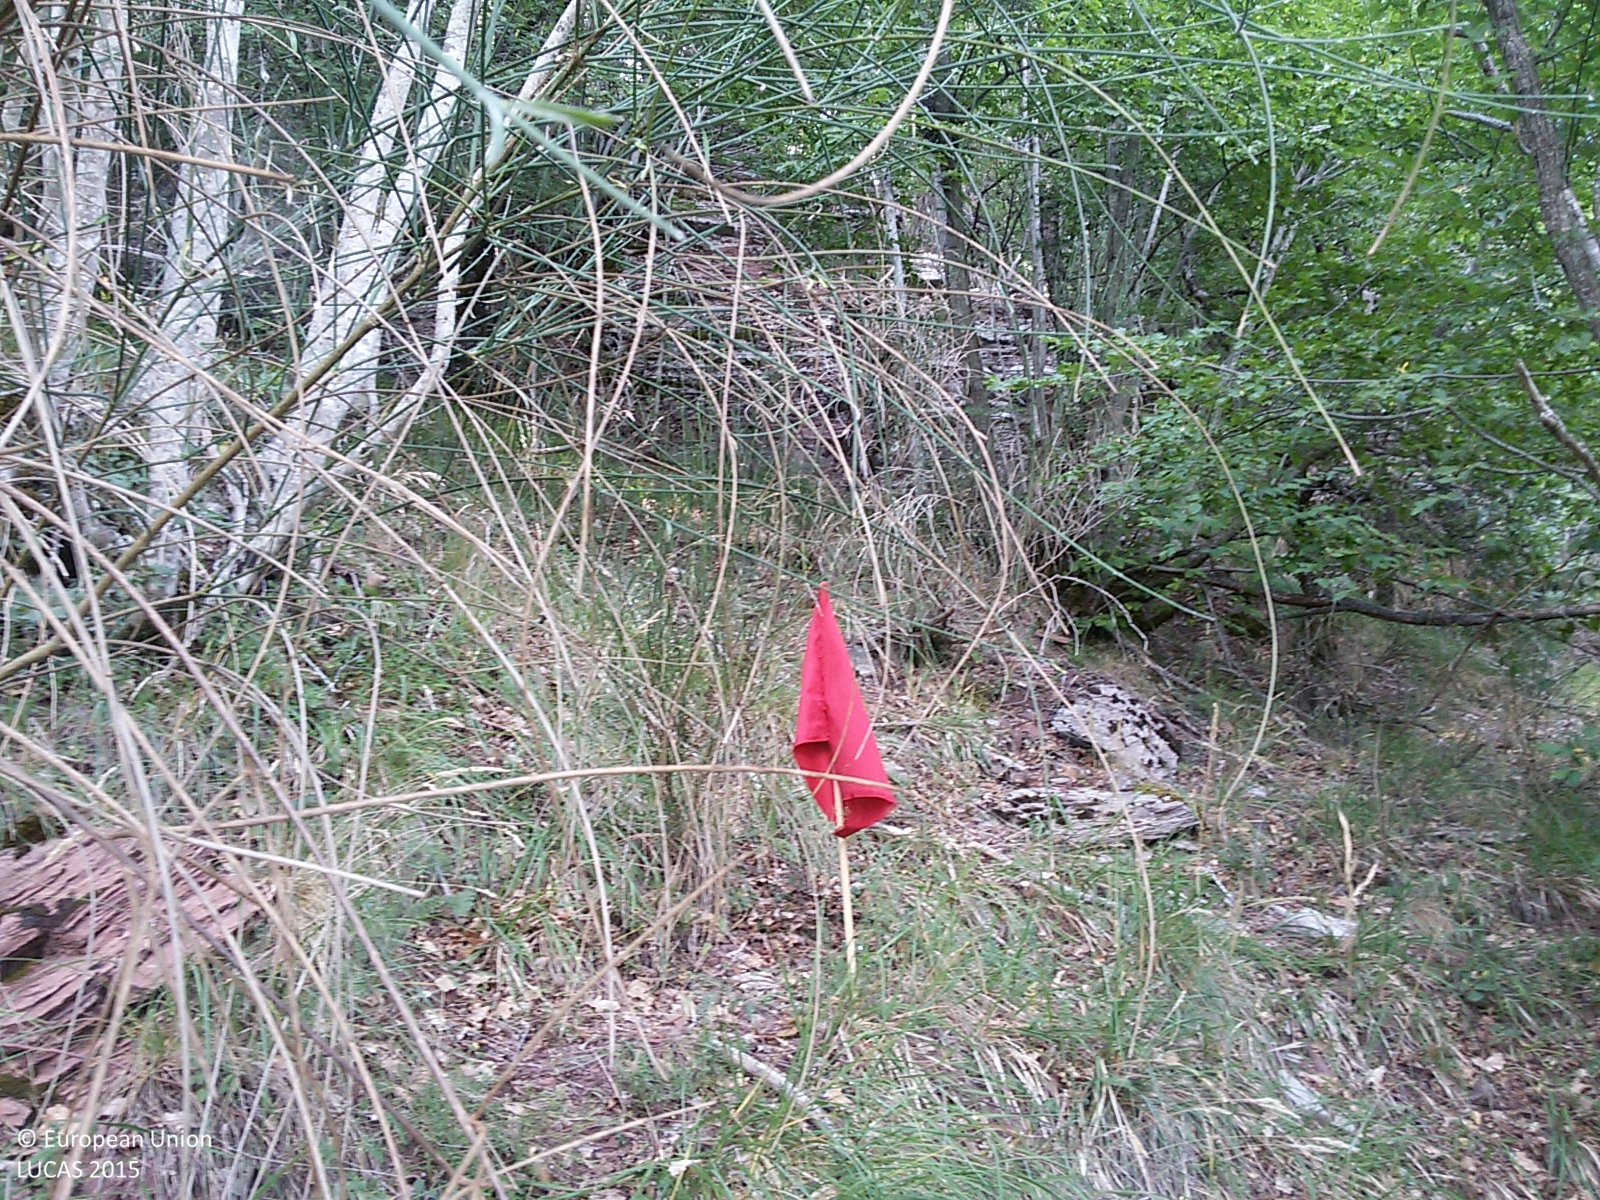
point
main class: Woodland
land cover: Broadleaved woodland
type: thermophilous deciduous forest
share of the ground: 50 - 75 %
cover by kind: broadleaved forest trees 55 %, shrubs 20 %, consolidated bare surface 15 %, herbaceous plants 10 %
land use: Semi-natural and natural areas not in use
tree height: < 5 m
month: July
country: IT
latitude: 42.8420
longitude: 11.4758
